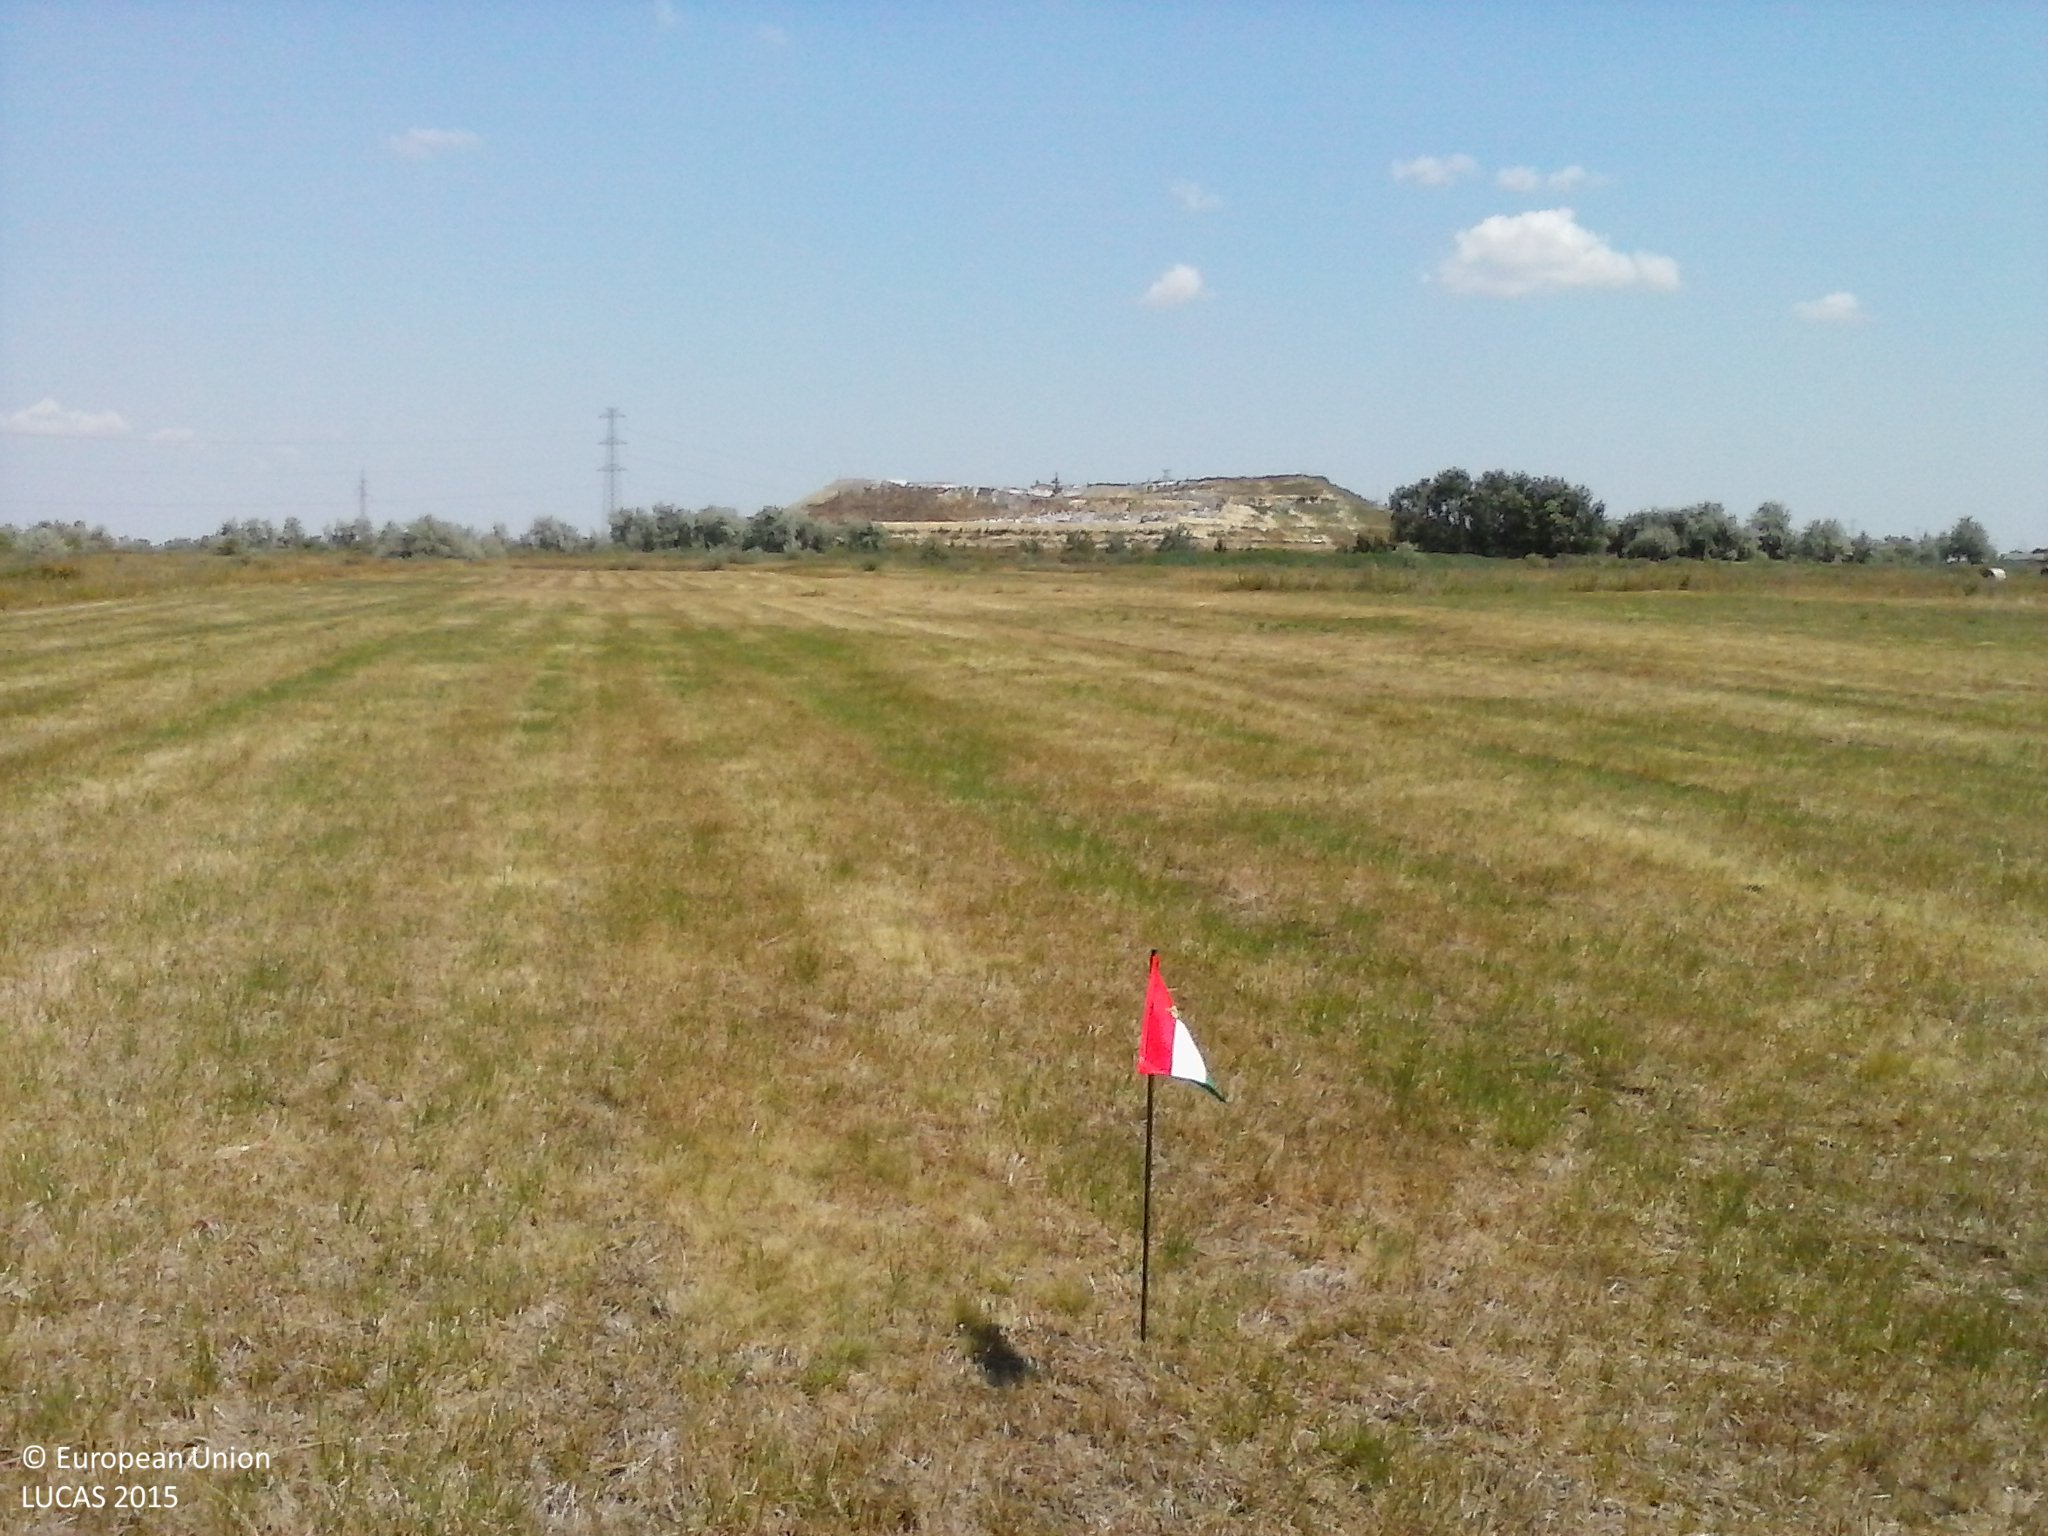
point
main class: Grassland
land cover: Grassland without tree/shrub cover
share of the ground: > 75 %
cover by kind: herbaceous plants 100 %
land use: Agriculture (excluding fallow land and kitchen gardens)
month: January
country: HU
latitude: 46.3757
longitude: 20.3338
